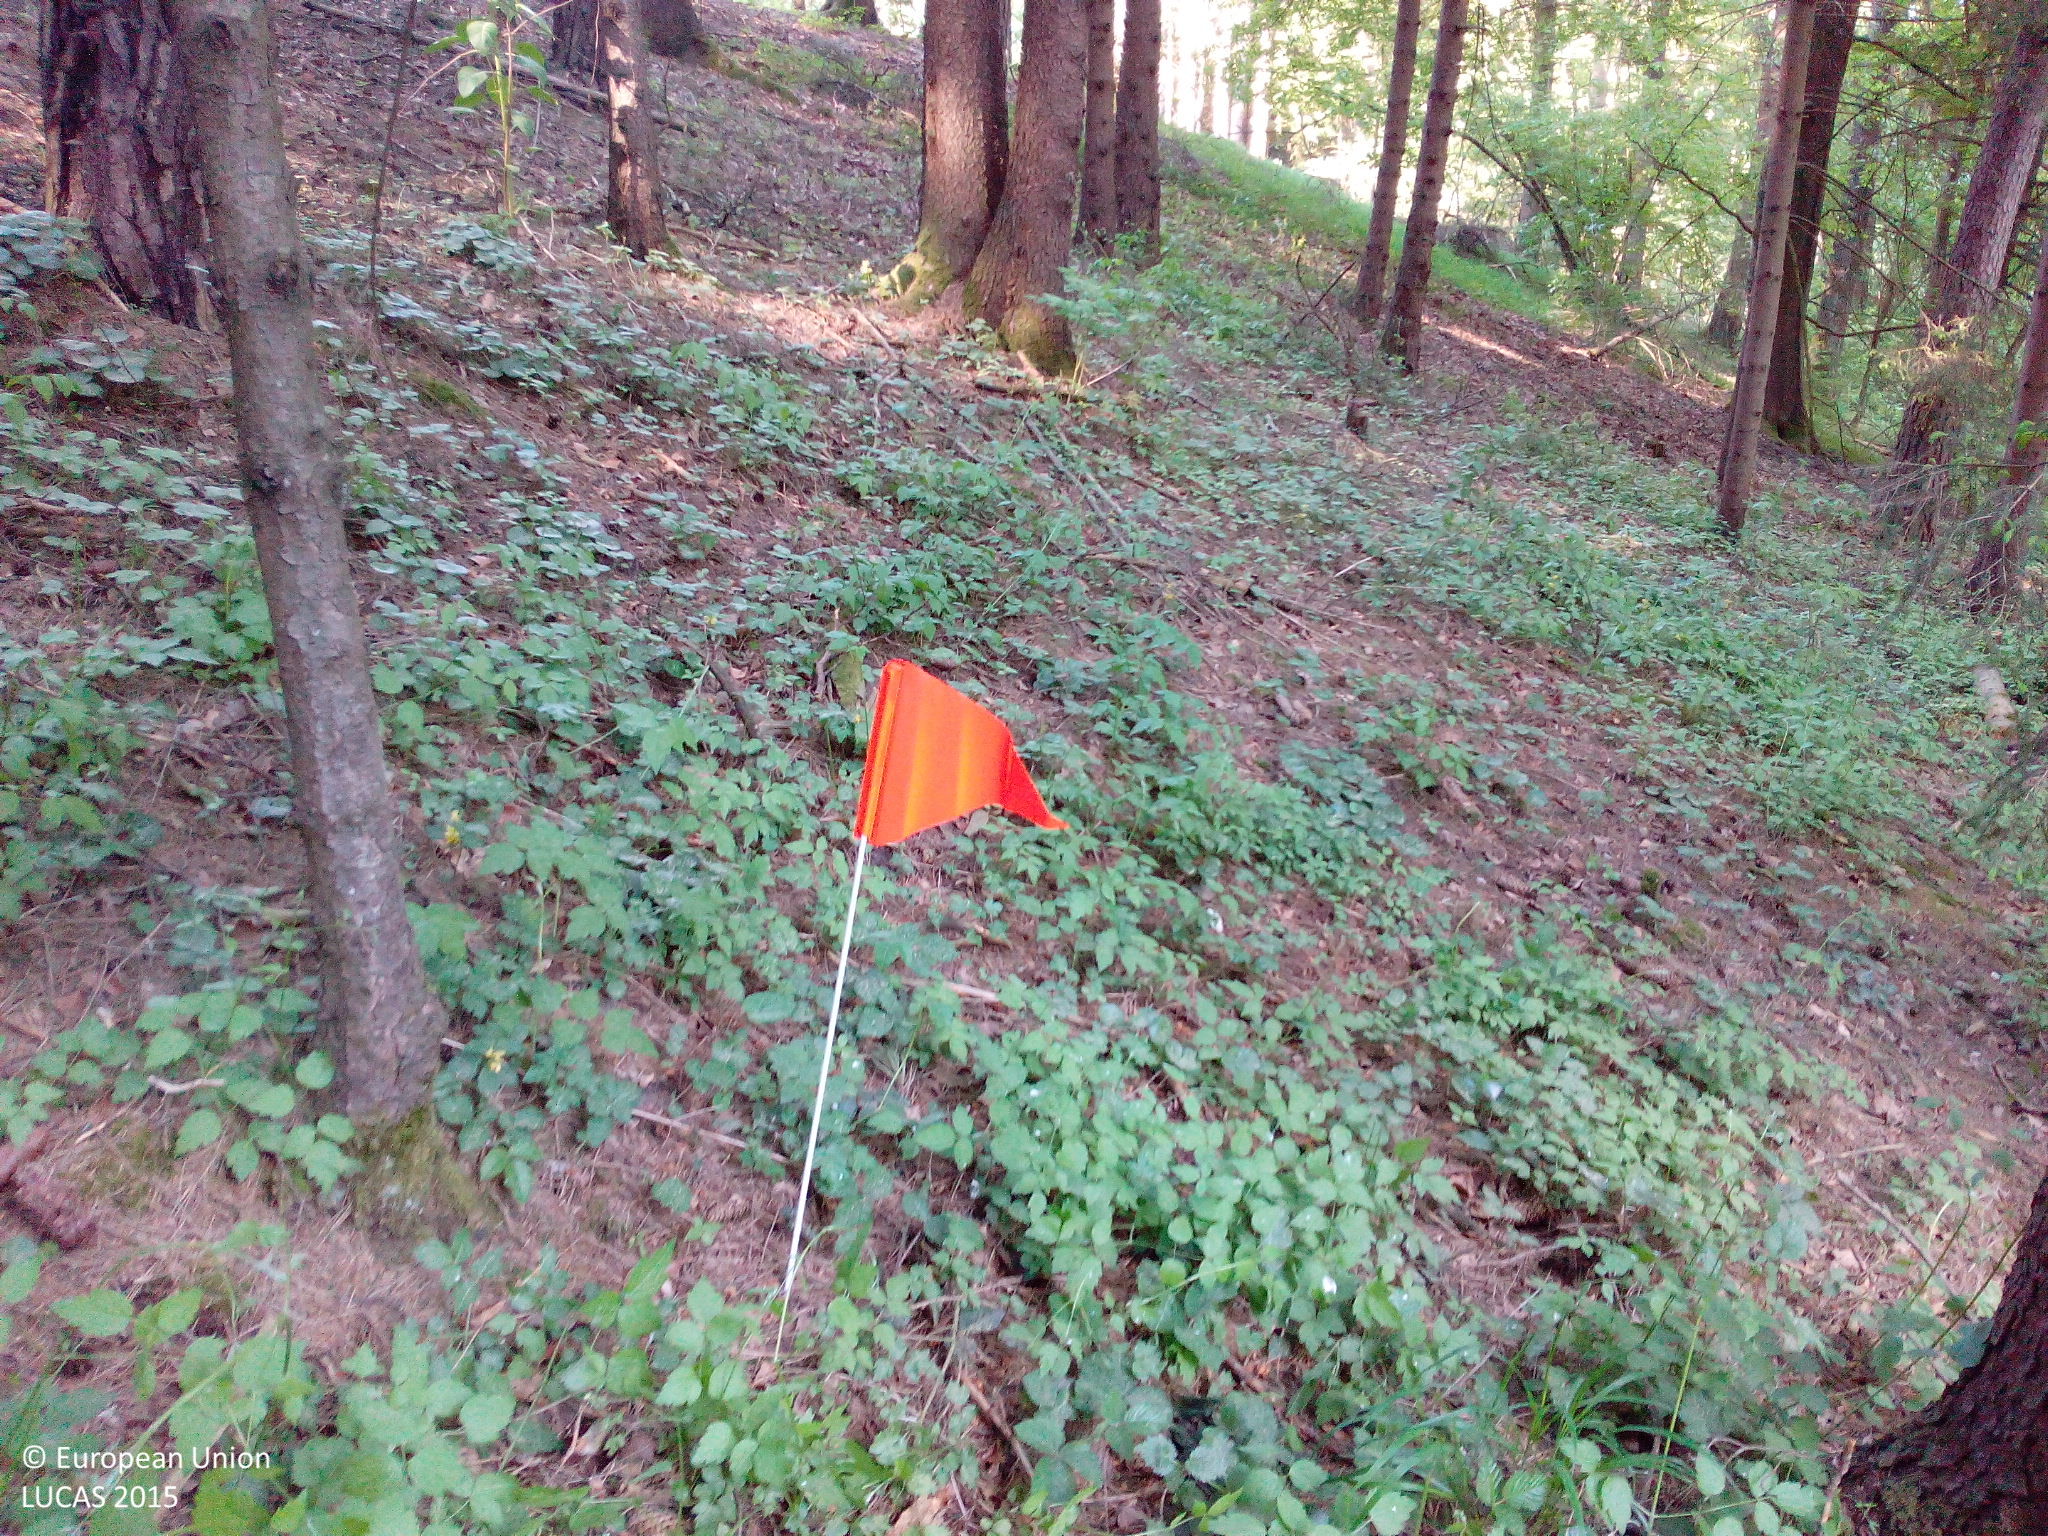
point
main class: Woodland
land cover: Other coniferous woodland
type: hemiboreal forest and nemoral coniferous forest and mixed broadleaved-coniferous forest
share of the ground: > 75 %
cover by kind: coniferous forest trees 85 %, unconsolidated bare surface 10 %, herbaceous plants 5 %
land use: Forestry
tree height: > 5 m
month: May
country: DE
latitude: 49.1851
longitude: 11.4949
